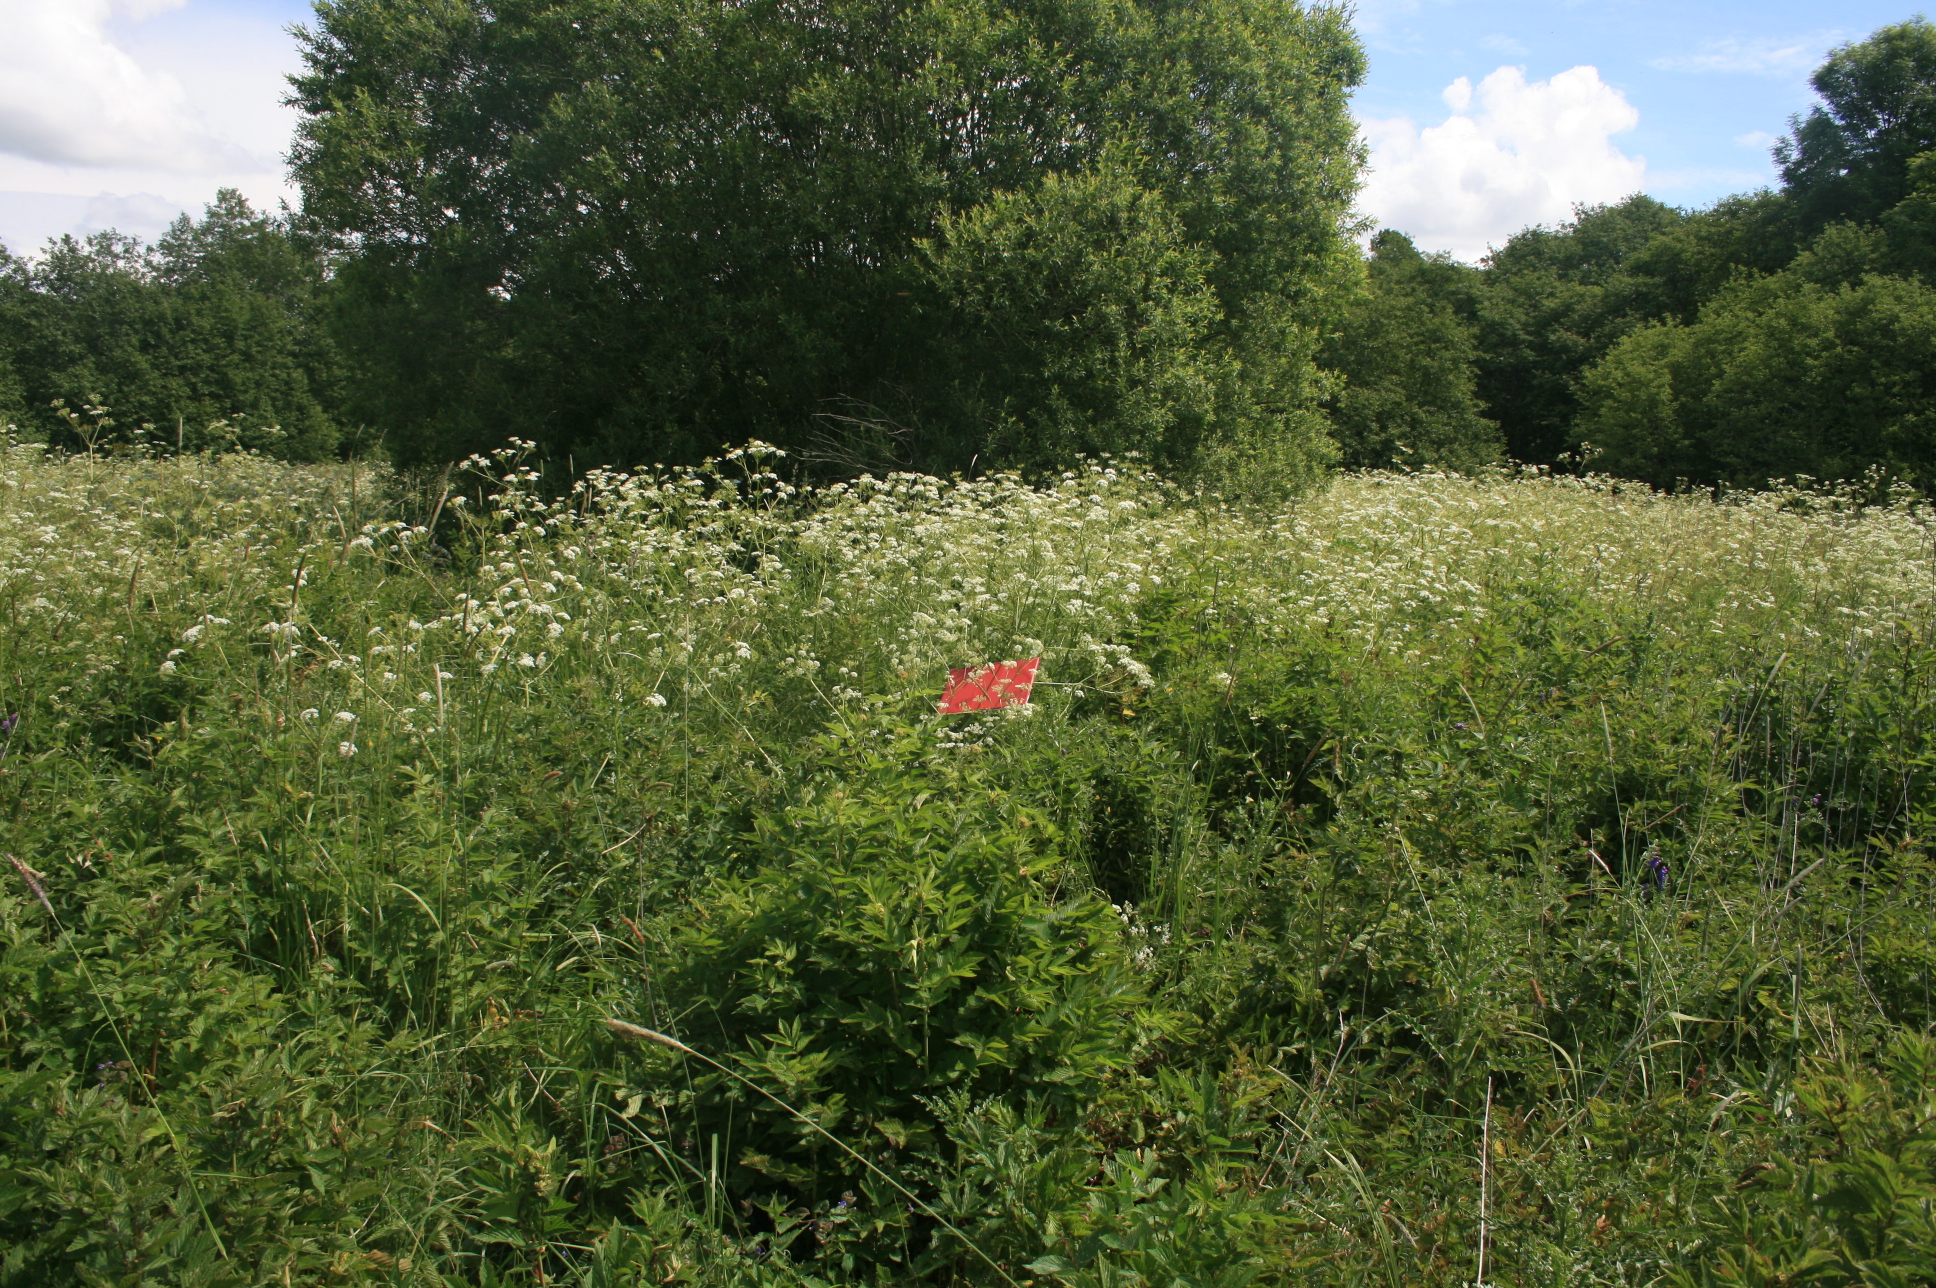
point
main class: Grassland
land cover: Spontaneously vegetated surfaces
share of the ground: > 75 %
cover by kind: herbaceous plants 100 %
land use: Fallow land
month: June
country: LT
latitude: 55.2643
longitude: 22.1258
